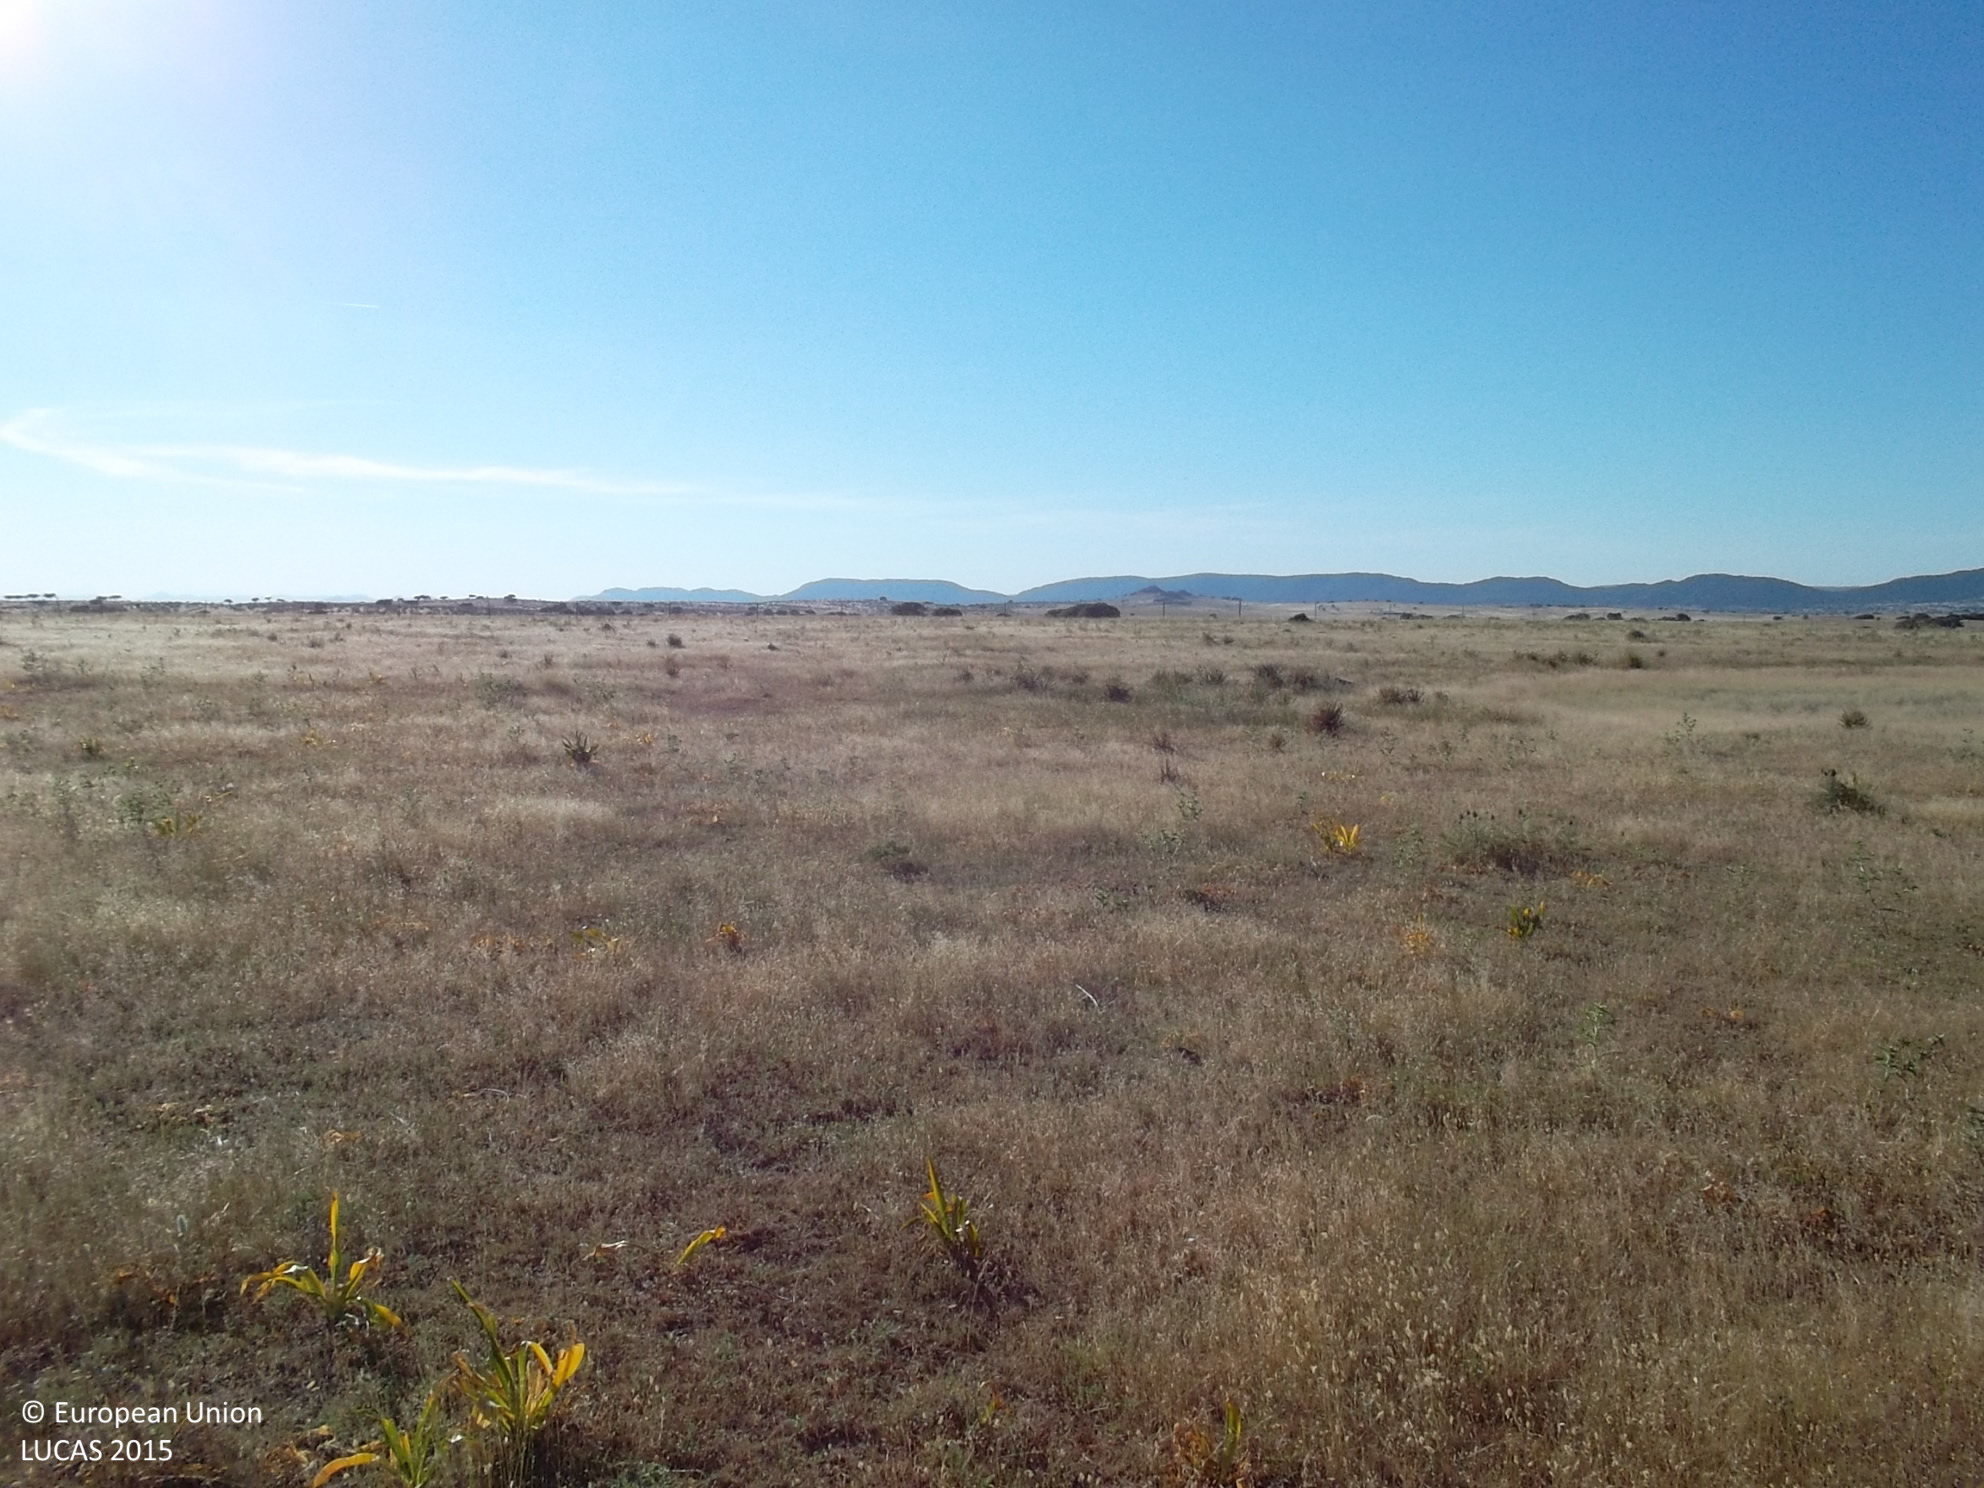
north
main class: Grassland
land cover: Grassland without tree/shrub cover
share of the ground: > 75 %
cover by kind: herbaceous plants 95 %, shrubs 5 %
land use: Agriculture (excluding fallow land and kitchen gardens)
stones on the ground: < 10 %
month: May
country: ES
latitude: 38.6174
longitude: -4.4818
